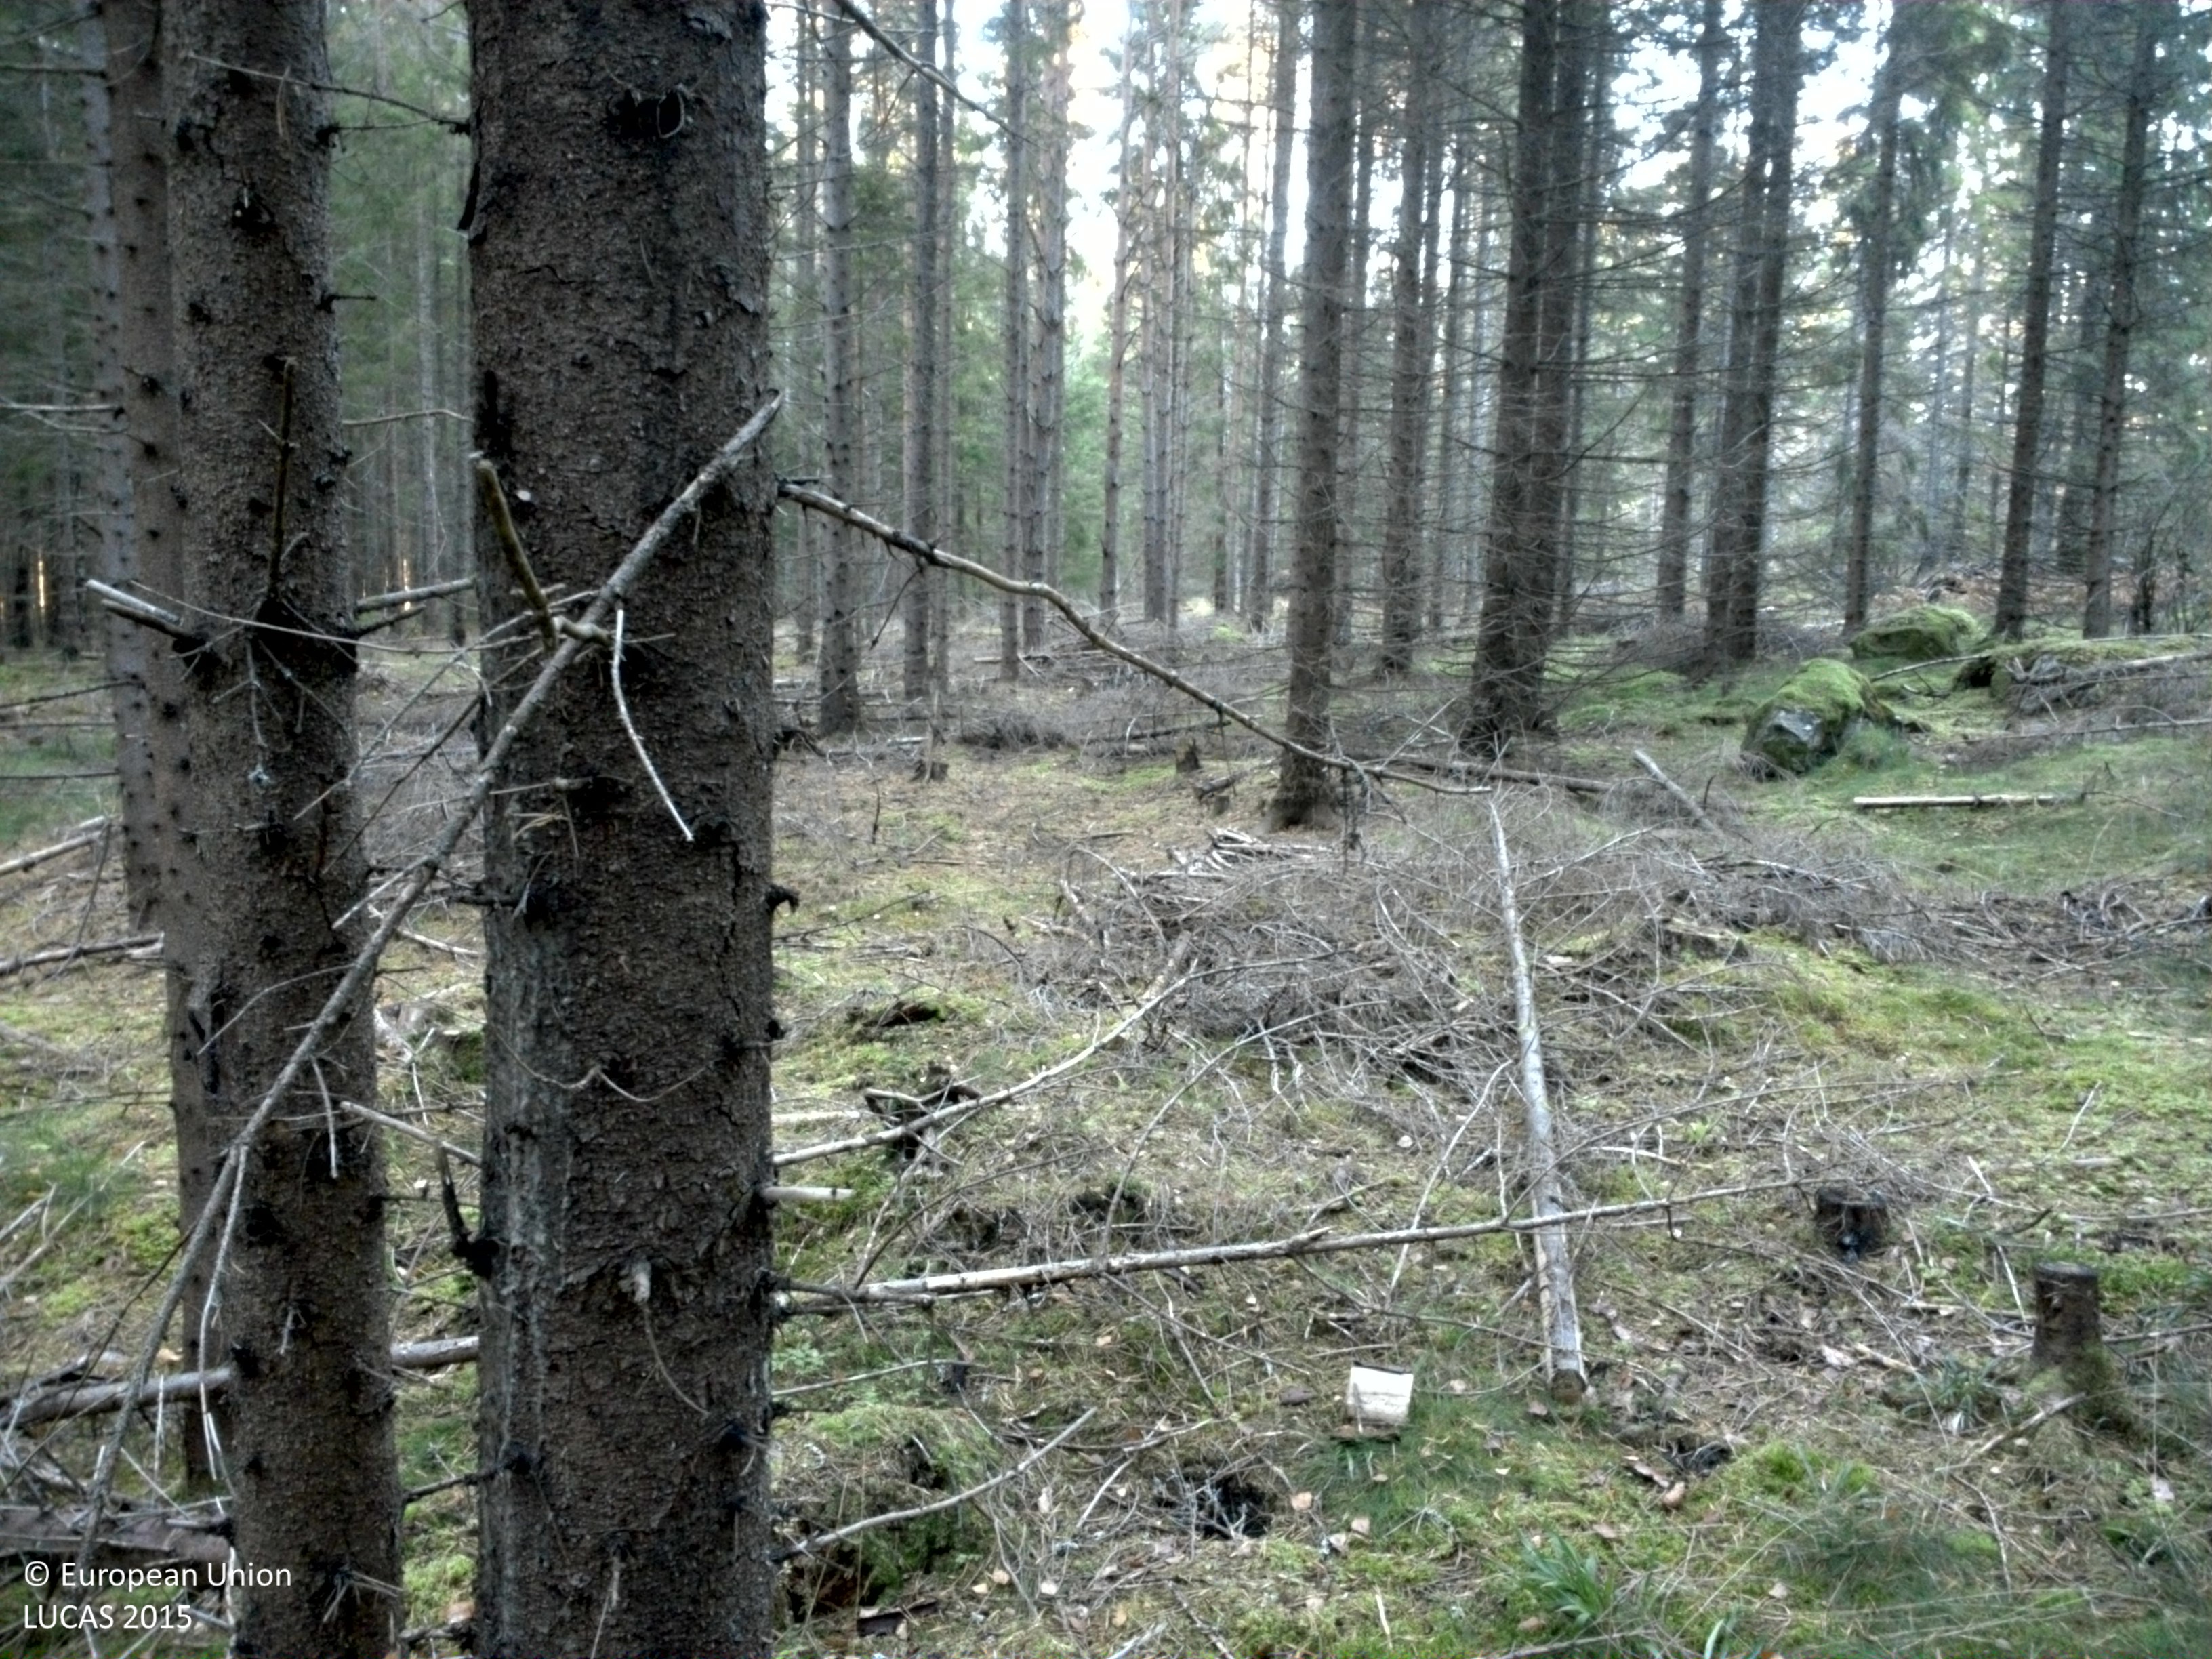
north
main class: Woodland
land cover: Spruce dominated coniferous woodland
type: boreal forest
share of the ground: 25 - 50 %
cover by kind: coniferous forest trees 50 %, lichens and mosses 40 %, shrubs 5 %, herbaceous plants 5 %
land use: Forestry
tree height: > 5 m
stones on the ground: 25 - 50 %
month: October
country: SE
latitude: 59.1367
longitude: 13.1564
